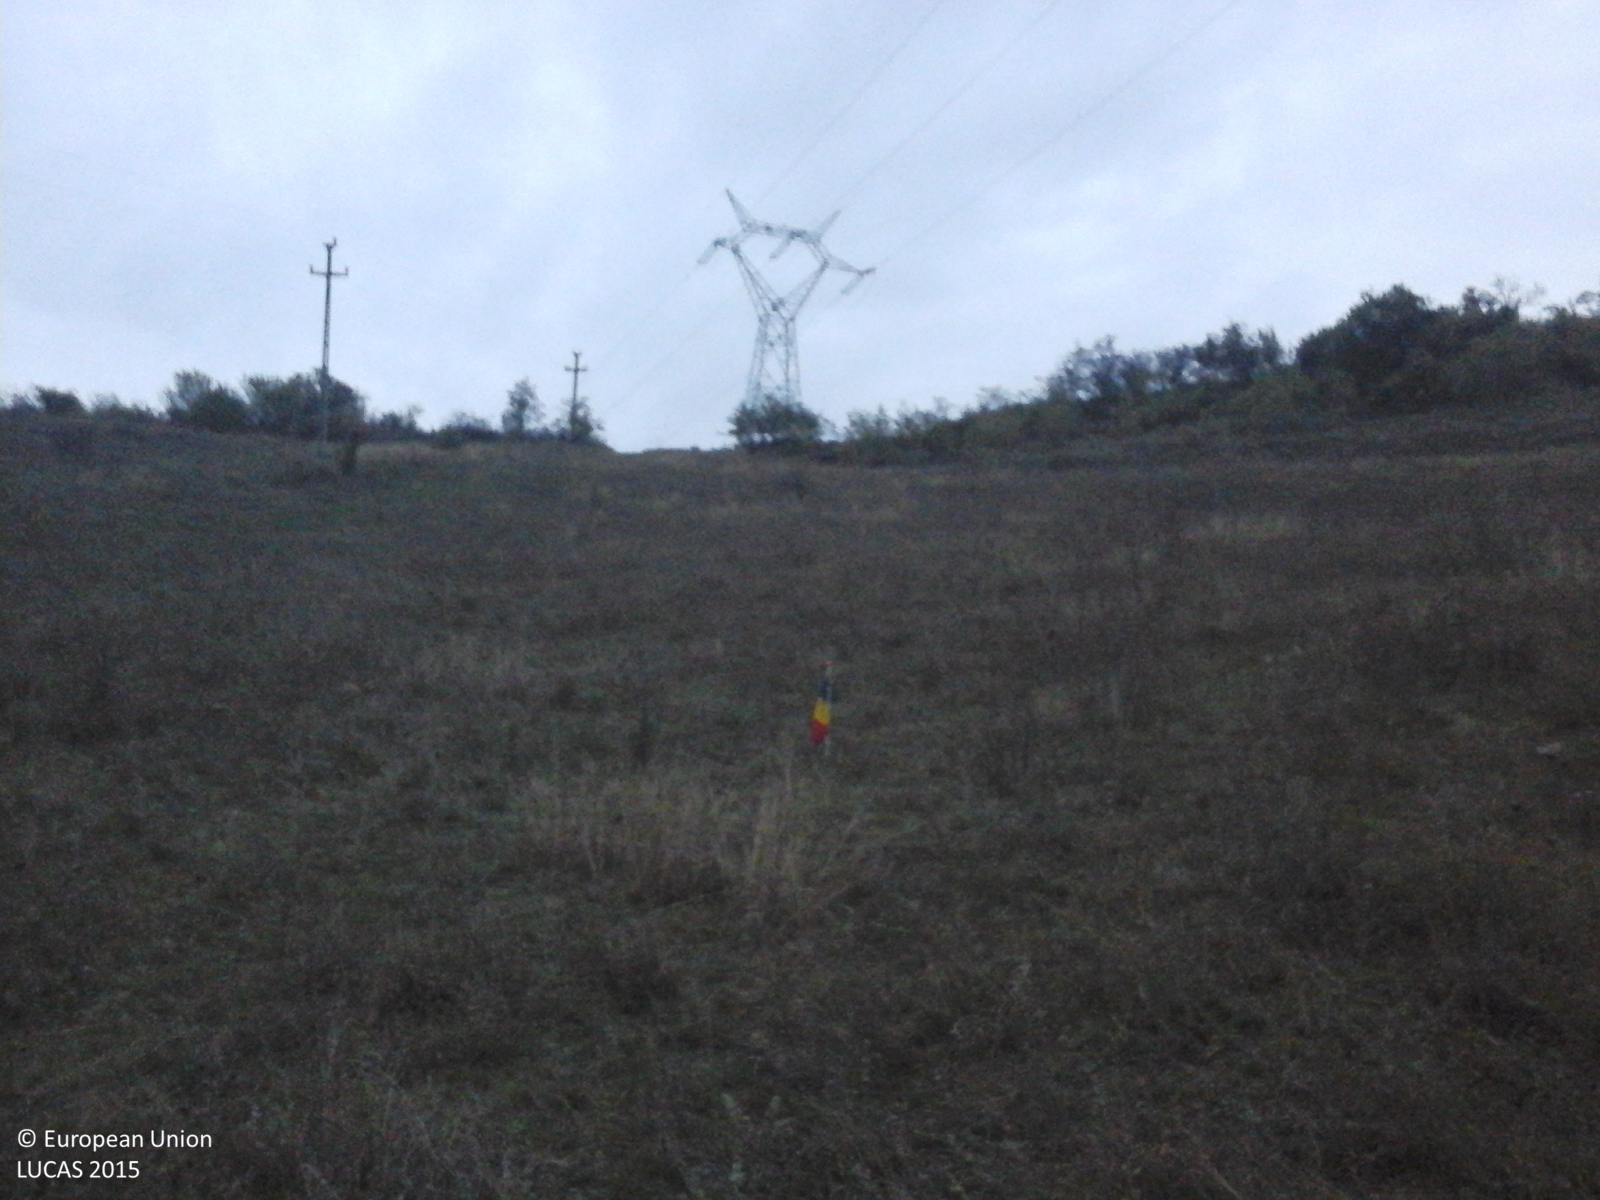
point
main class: Grassland
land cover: Grassland without tree/shrub cover
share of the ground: > 75 %
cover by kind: herbaceous plants 100 %
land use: Agriculture (excluding fallow land and kitchen gardens)
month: October
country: RO
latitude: 46.4224
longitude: 24.7292
